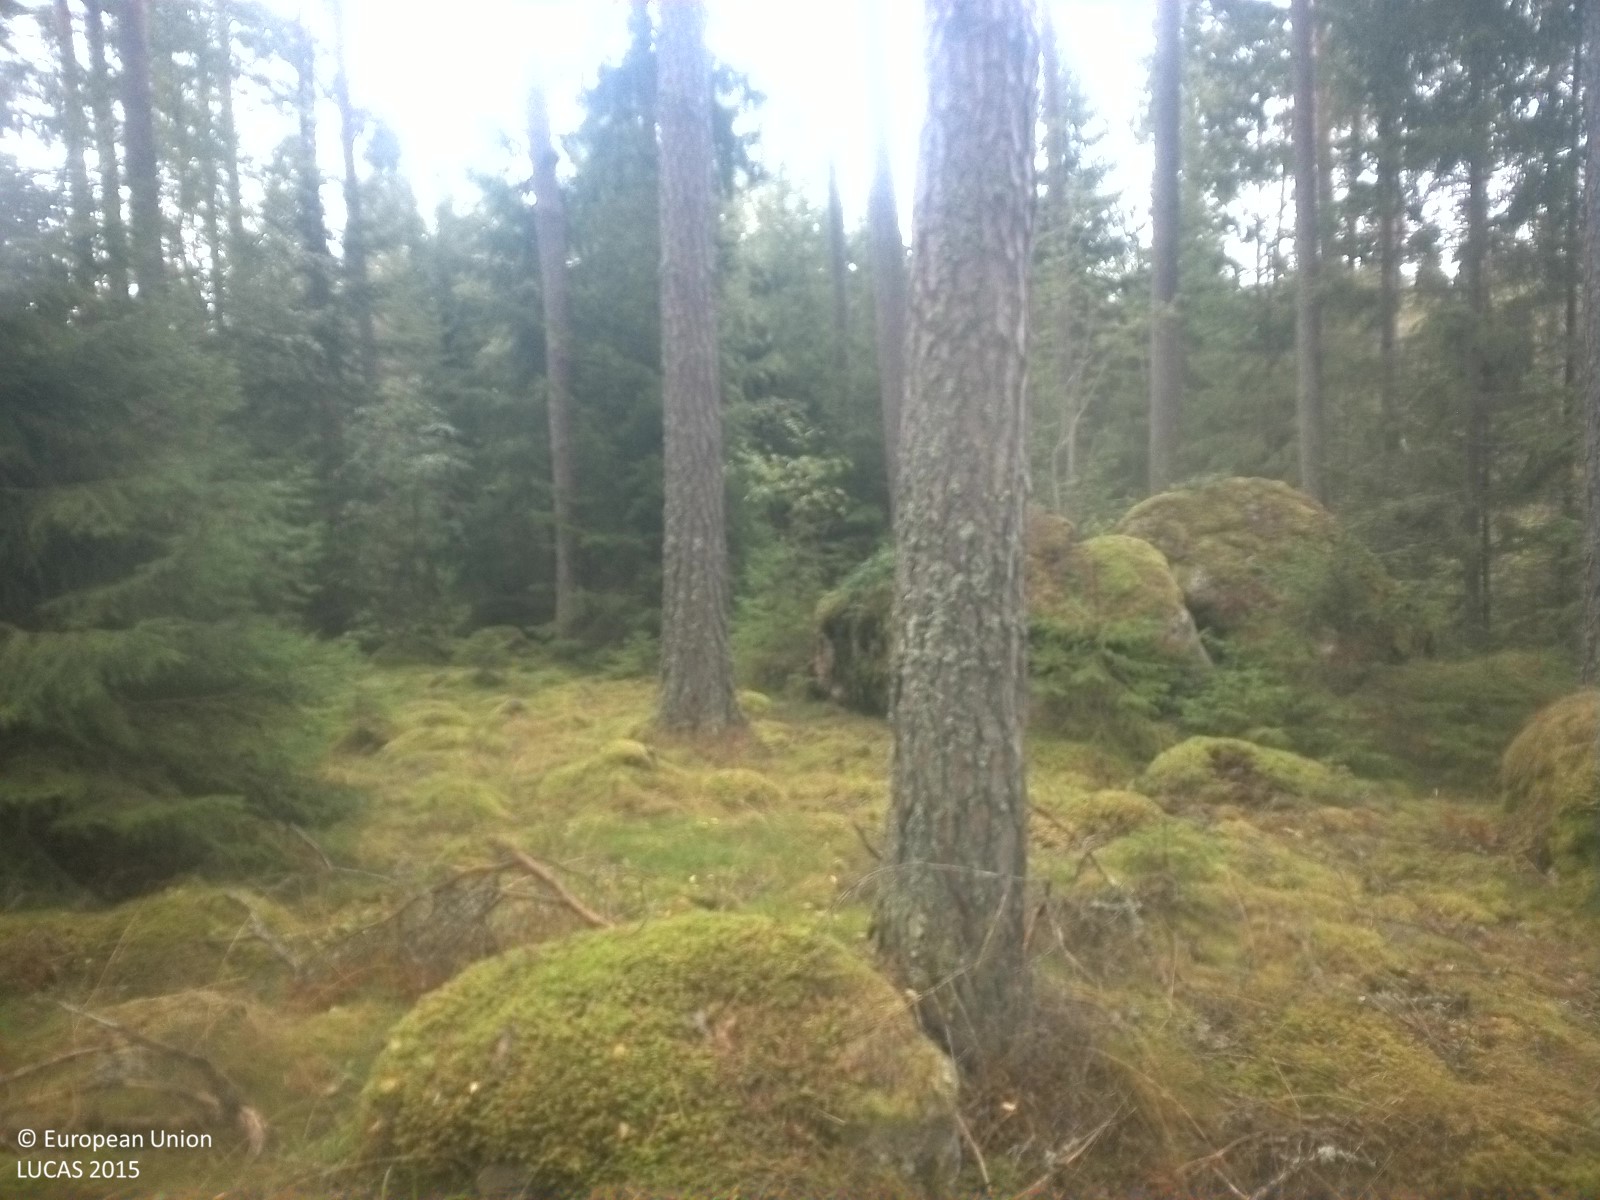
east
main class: Woodland
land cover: Pine dominated coniferous woodland
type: boreal forest
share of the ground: 25 - 50 %
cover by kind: lichens and mosses 55 %, coniferous forest trees 30 %, herbaceous plants 15 %
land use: Forestry
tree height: > 5 m
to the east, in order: Pine dominated coniferous woodland; Spruce dominated mixed woodland; Tracks; Spruce dominated mixed woodland; Ditches and canals; Spruce dominated mixed woodland; Ditches and canals; Spruce dominated coniferous woodland
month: September
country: SE
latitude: 59.3820
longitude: 15.6421
